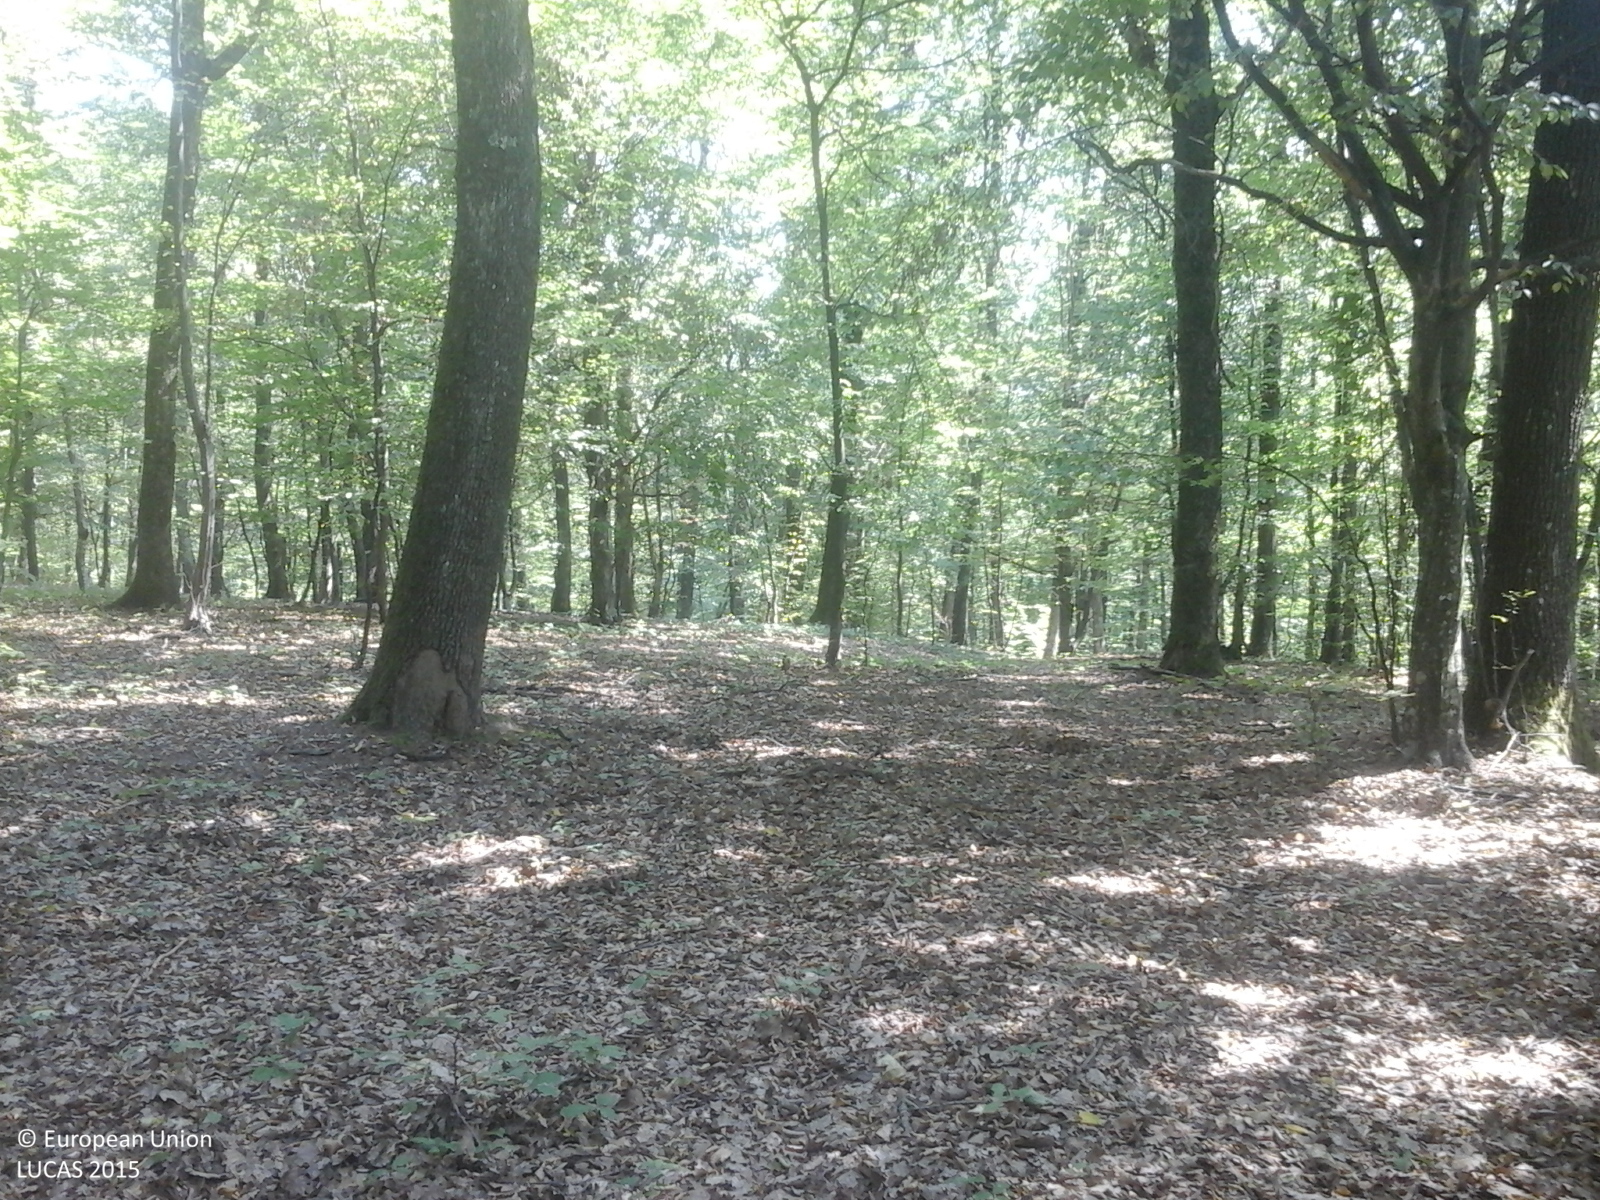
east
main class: Woodland
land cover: Broadleaved woodland
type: mesophytic deciduous forest
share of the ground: > 75 %
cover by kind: broadleaved forest trees 100 %
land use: Forestry
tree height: > 5 m
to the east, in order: Broadleaved woodland; Tracks; Broadleaved woodland
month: August
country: RO
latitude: 46.4931
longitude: 22.1499
